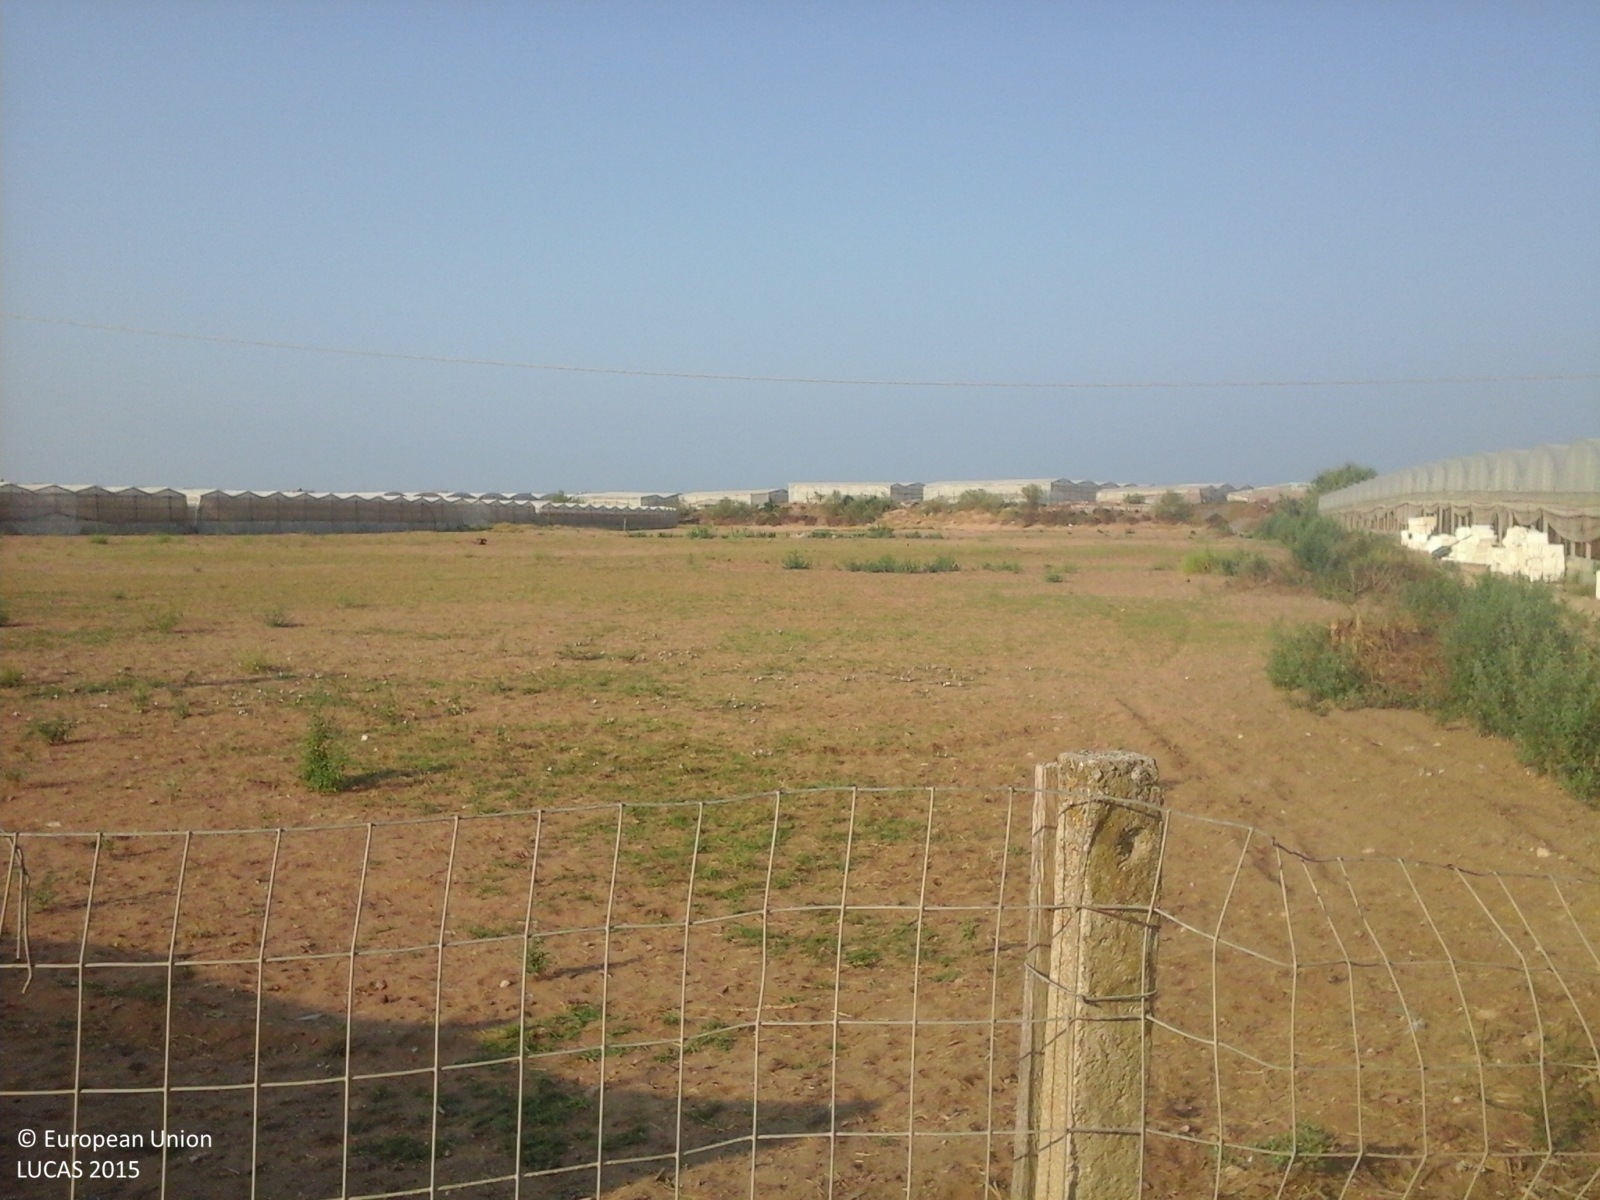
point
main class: Grassland
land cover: Spontaneously vegetated surfaces
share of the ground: > 75 %
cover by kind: herbaceous plants 100 %
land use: Fallow land
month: July
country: IT
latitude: 36.9738
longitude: 14.3797
